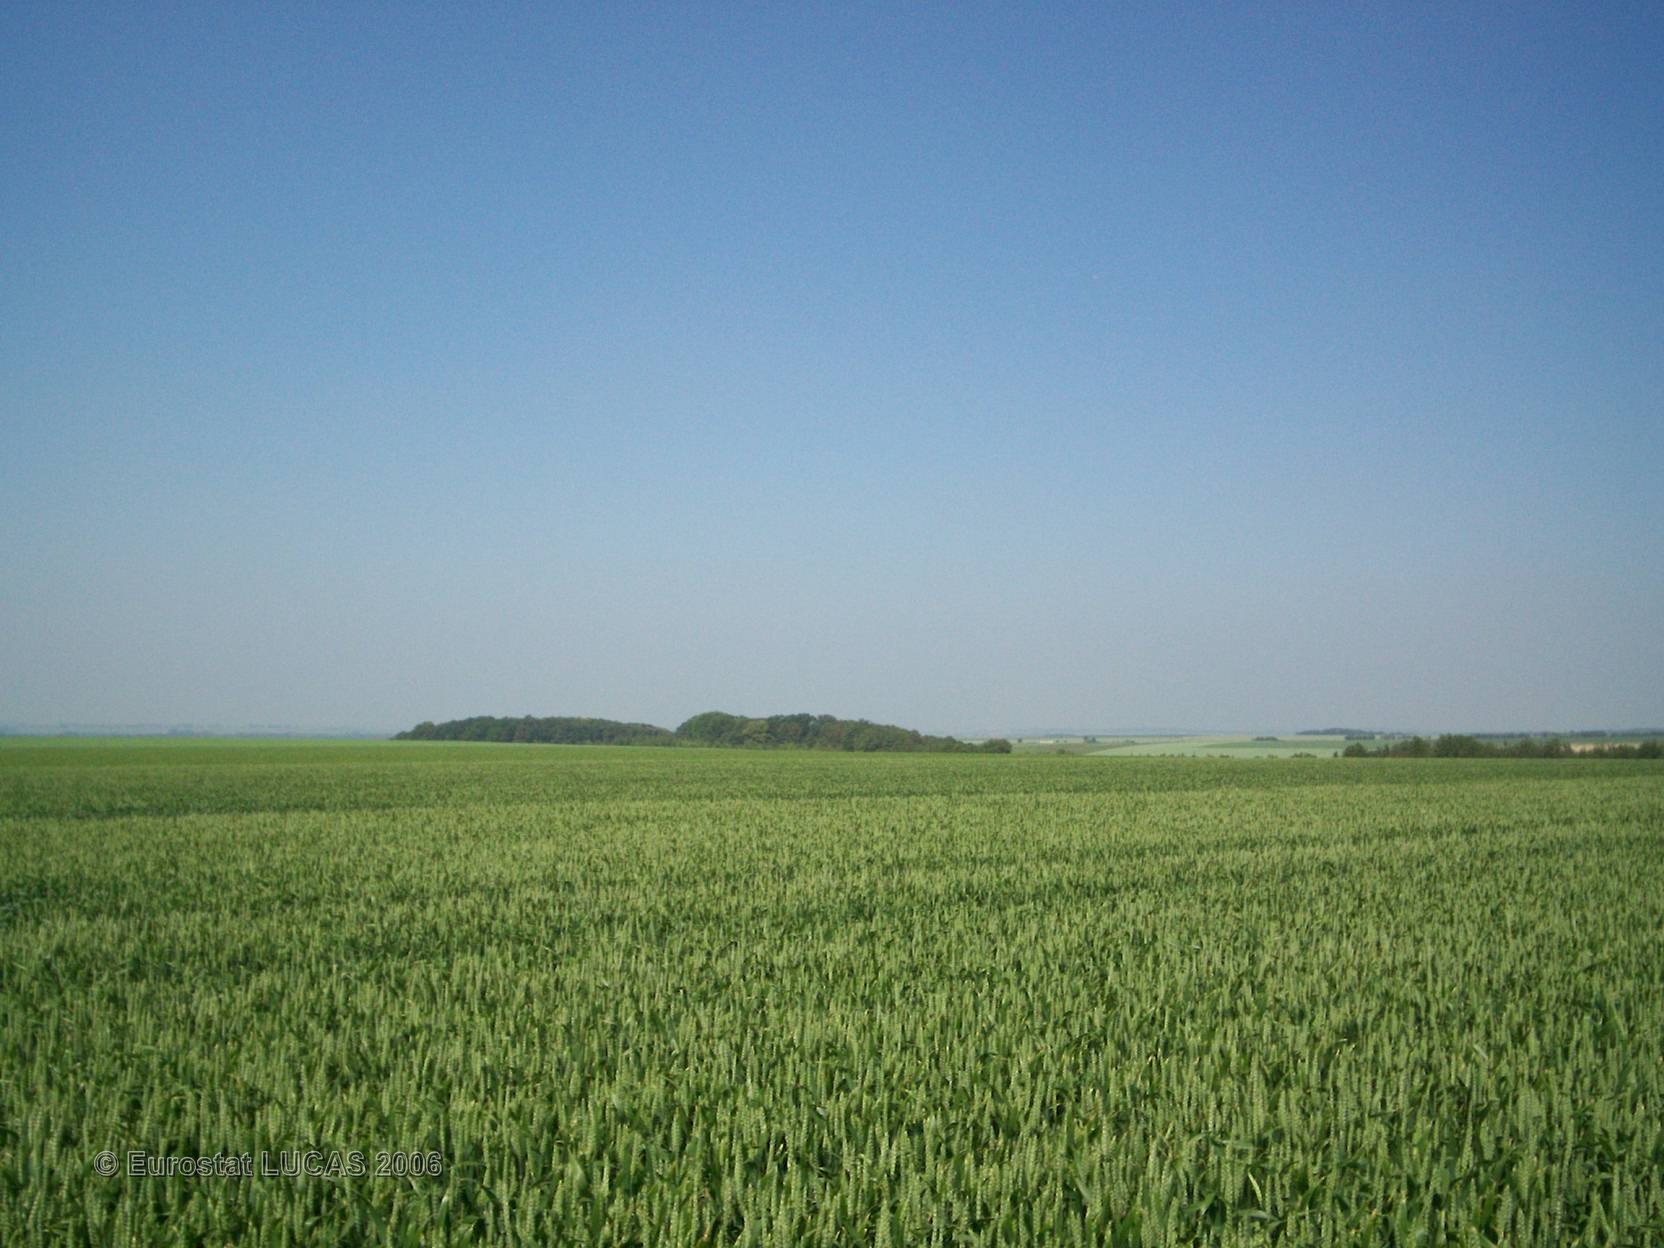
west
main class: Cropland
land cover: Common wheat
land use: Agriculture (excluding fallow land and kitchen gardens)
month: June
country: FR
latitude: 49.4995
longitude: 2.7124
